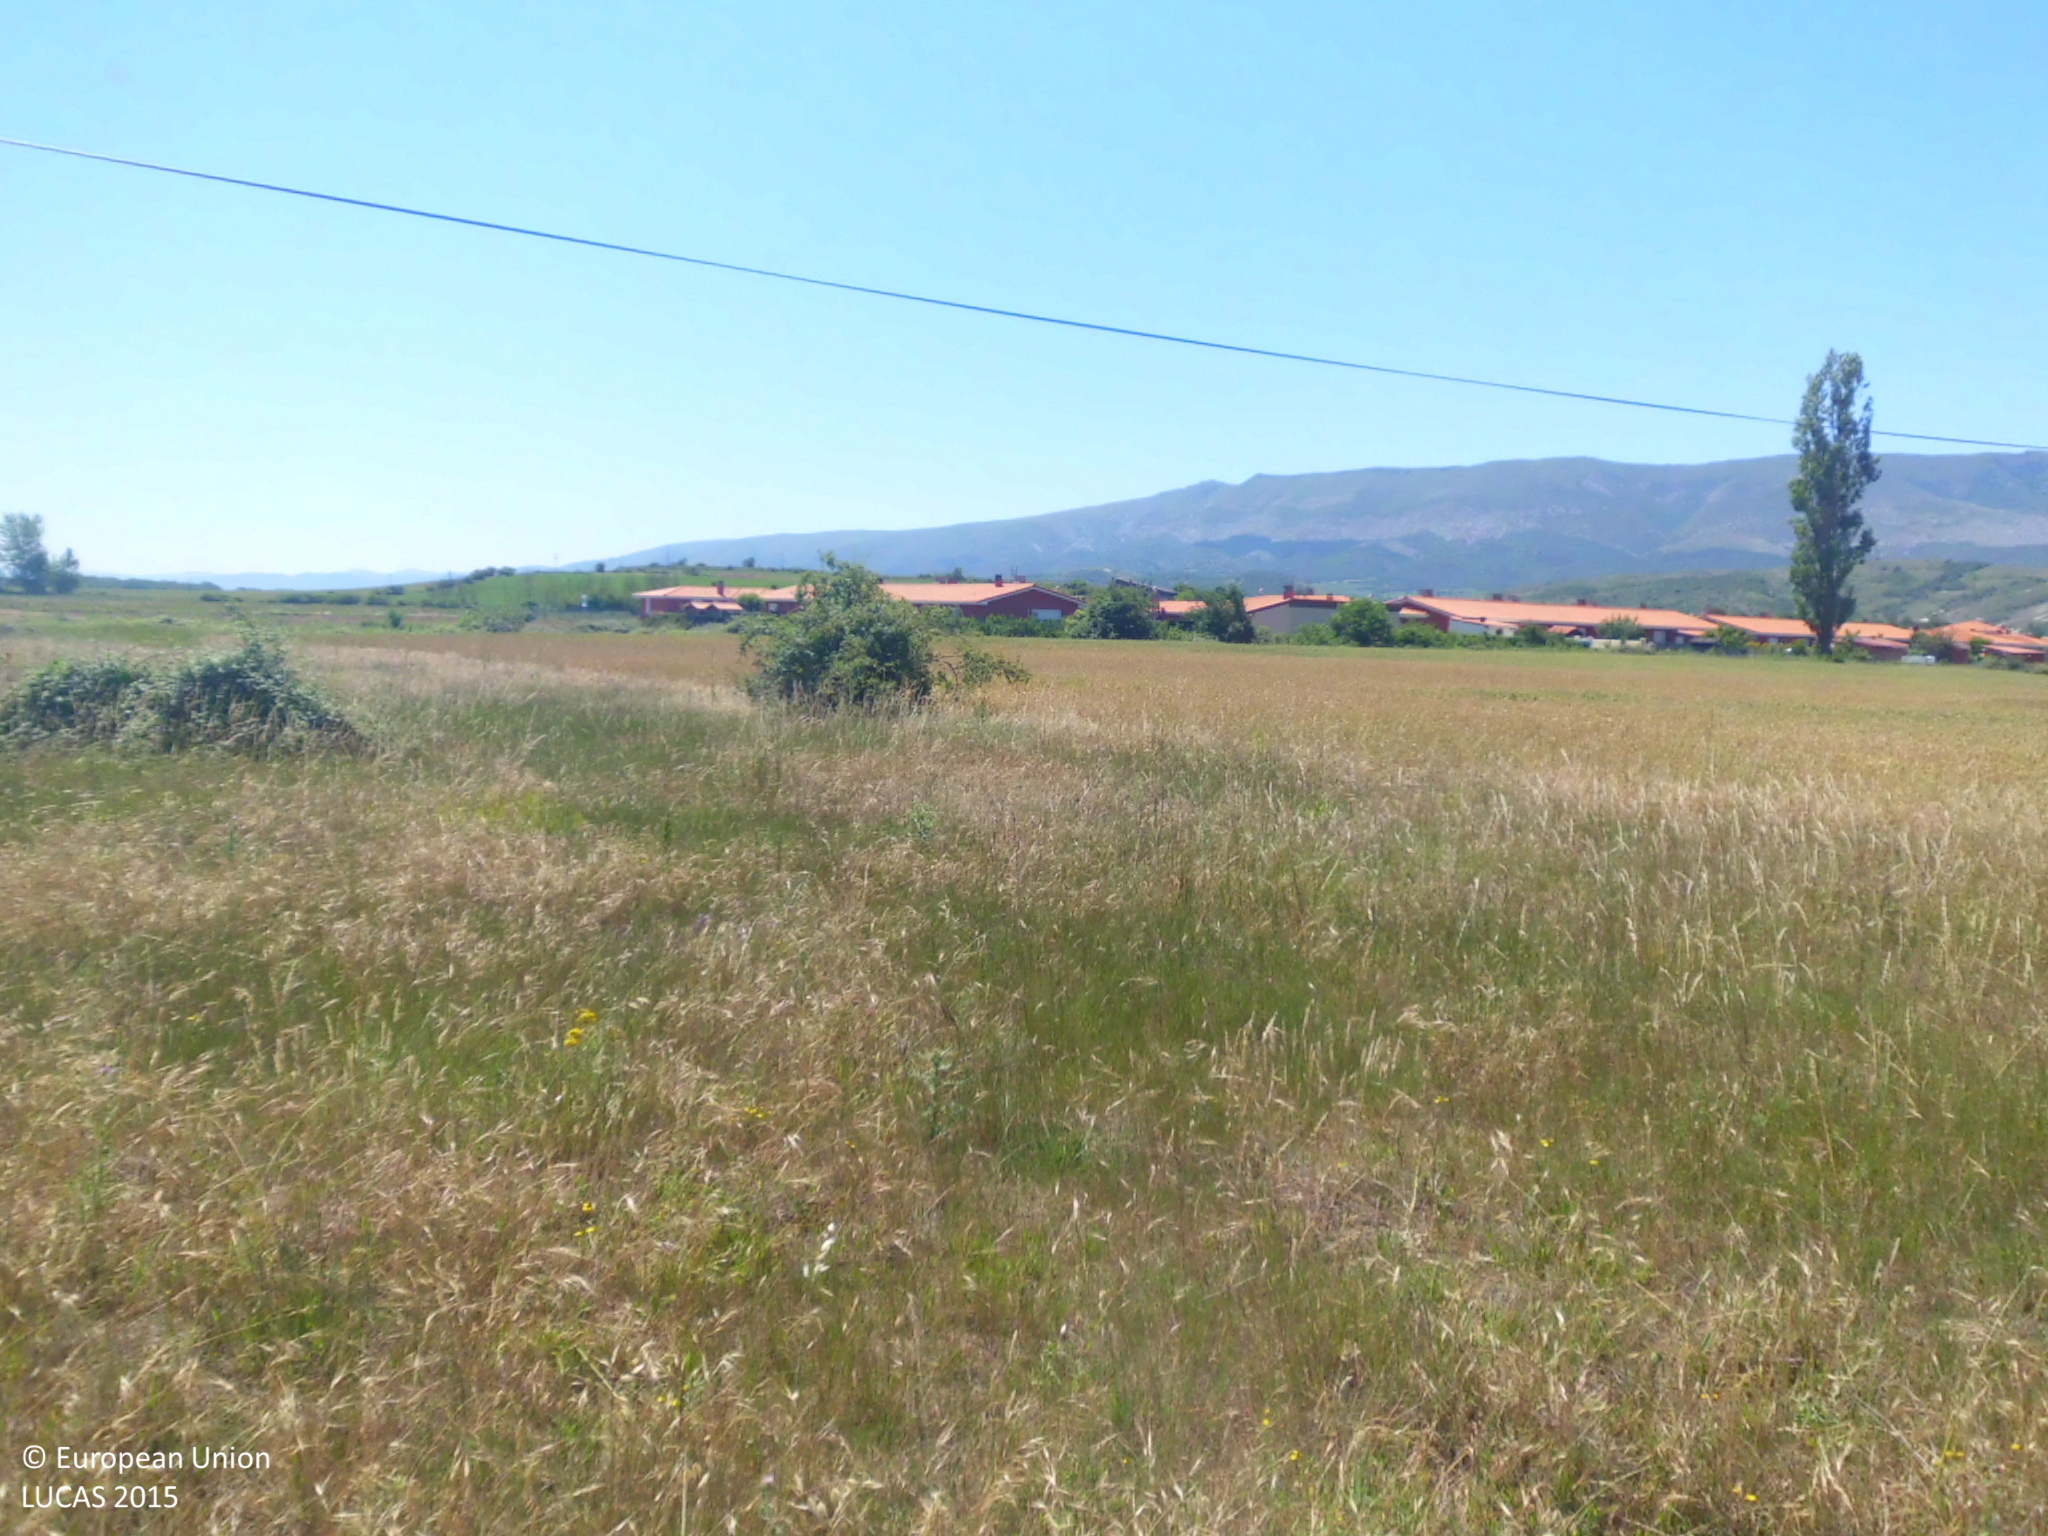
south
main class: Grassland
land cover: Grassland without tree/shrub cover
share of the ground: > 75 %
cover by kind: herbaceous plants 100 %
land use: Agriculture (excluding fallow land and kitchen gardens)
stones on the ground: 25 - 50 %
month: June
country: ES
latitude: 42.9153
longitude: -3.5018
